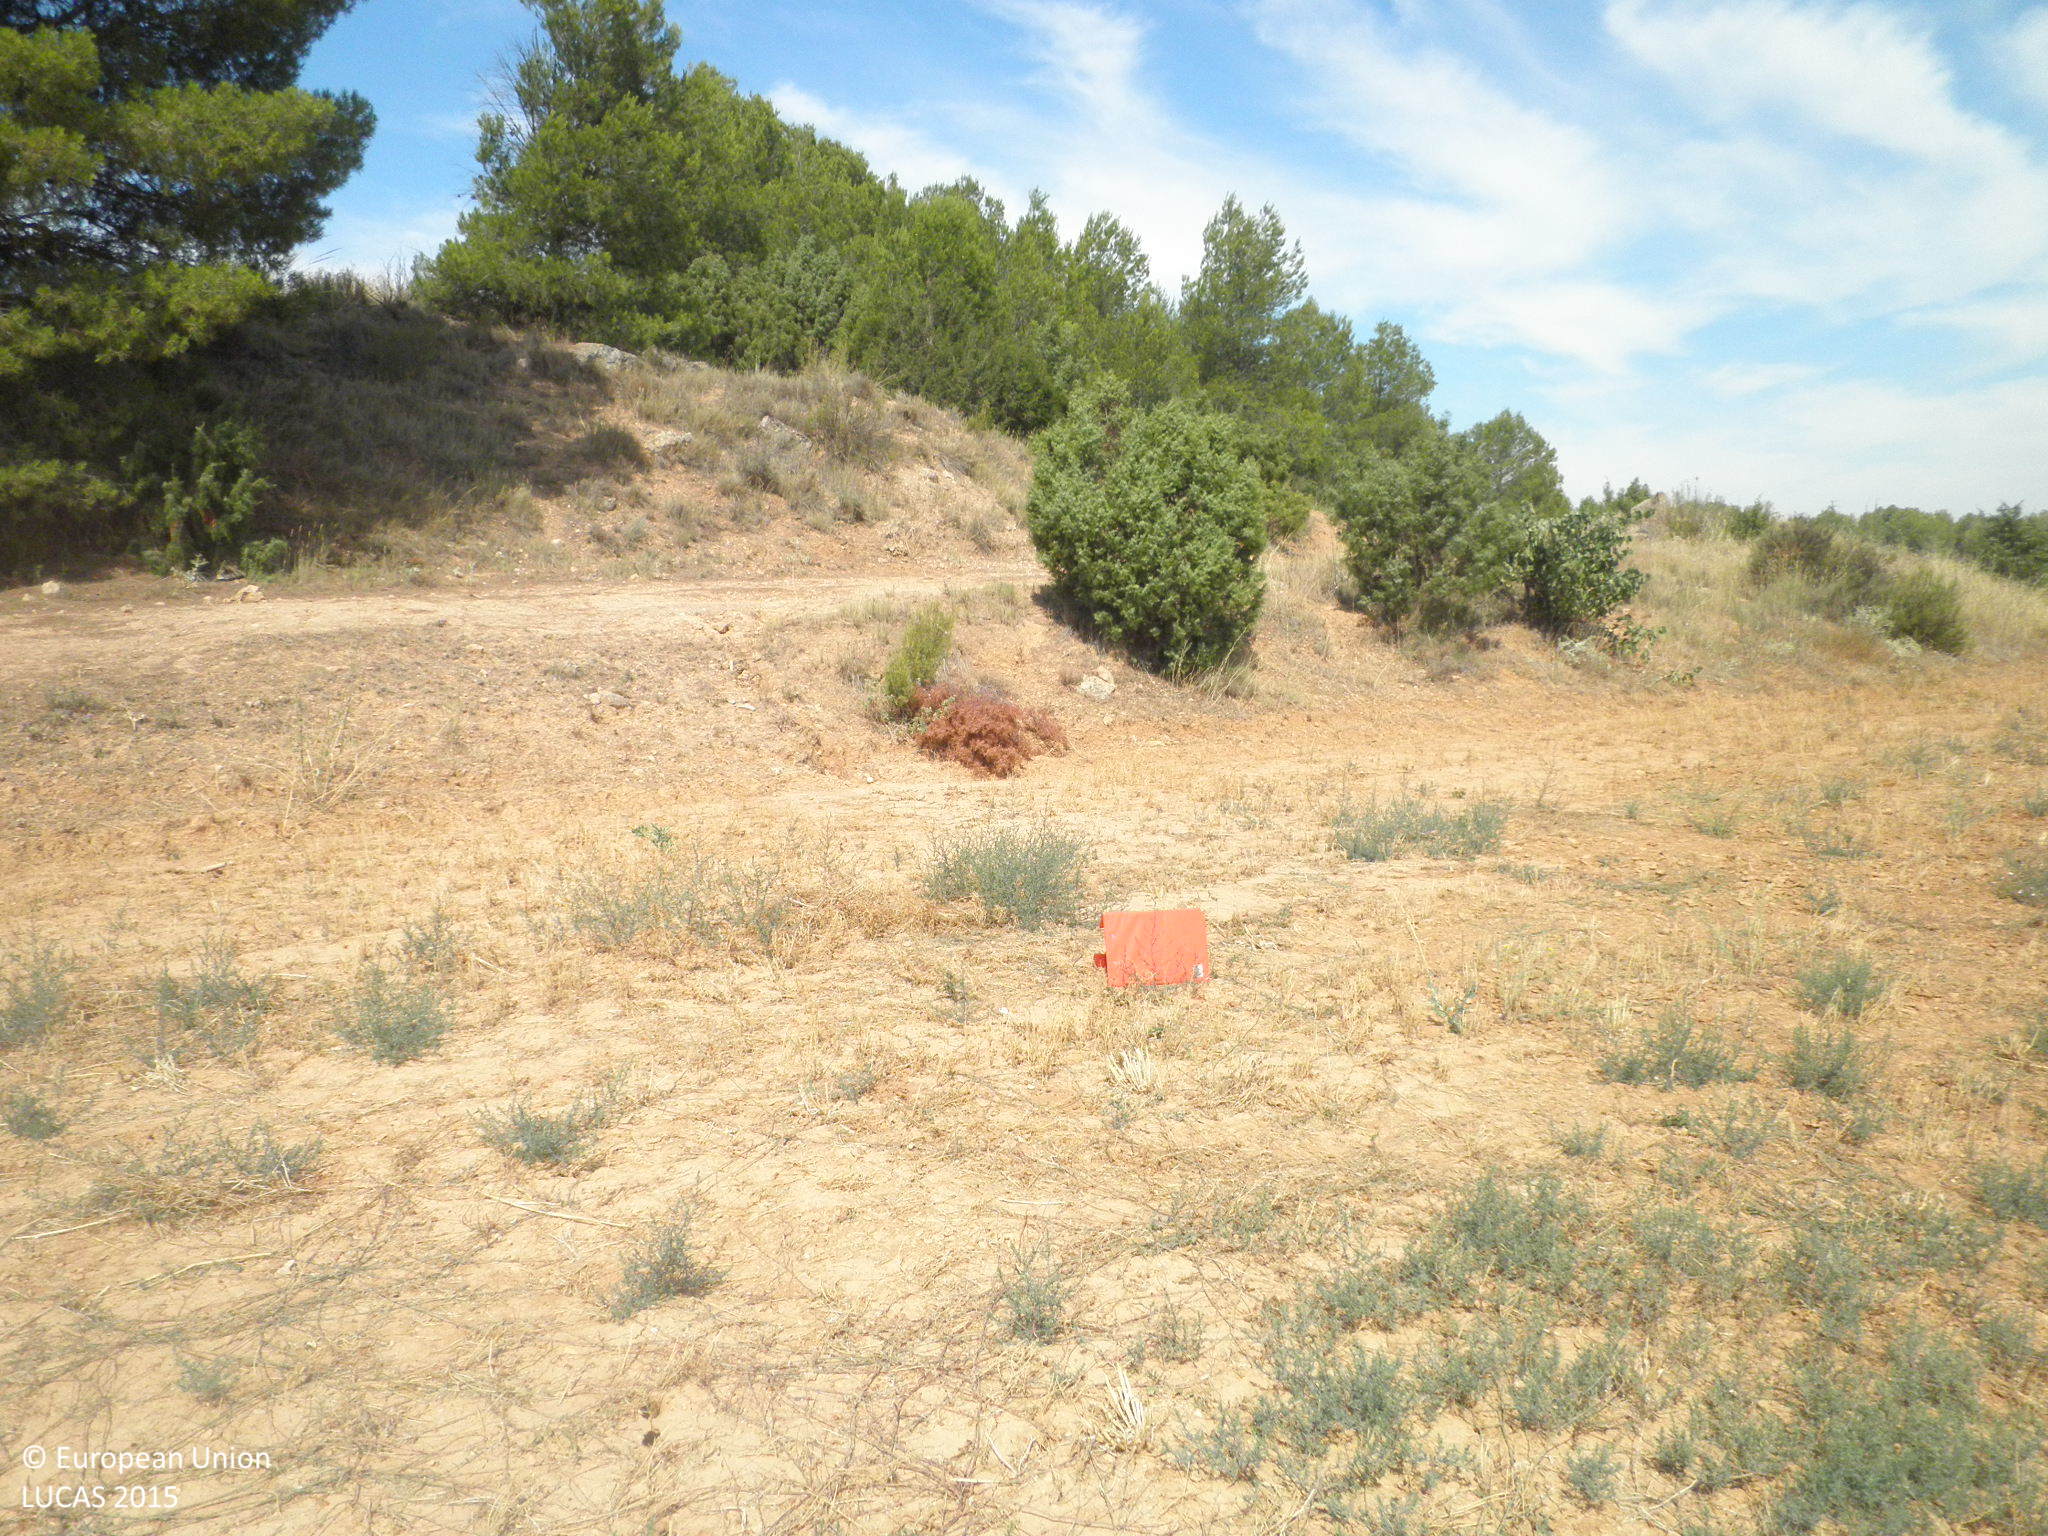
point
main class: Grassland
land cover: Spontaneously vegetated surfaces
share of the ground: 10 - 25 %
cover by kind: unconsolidated bare surface 75 %, herbaceous plants 25 %
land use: Fallow land
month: July
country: ES
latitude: 39.4735
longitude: -1.5472
